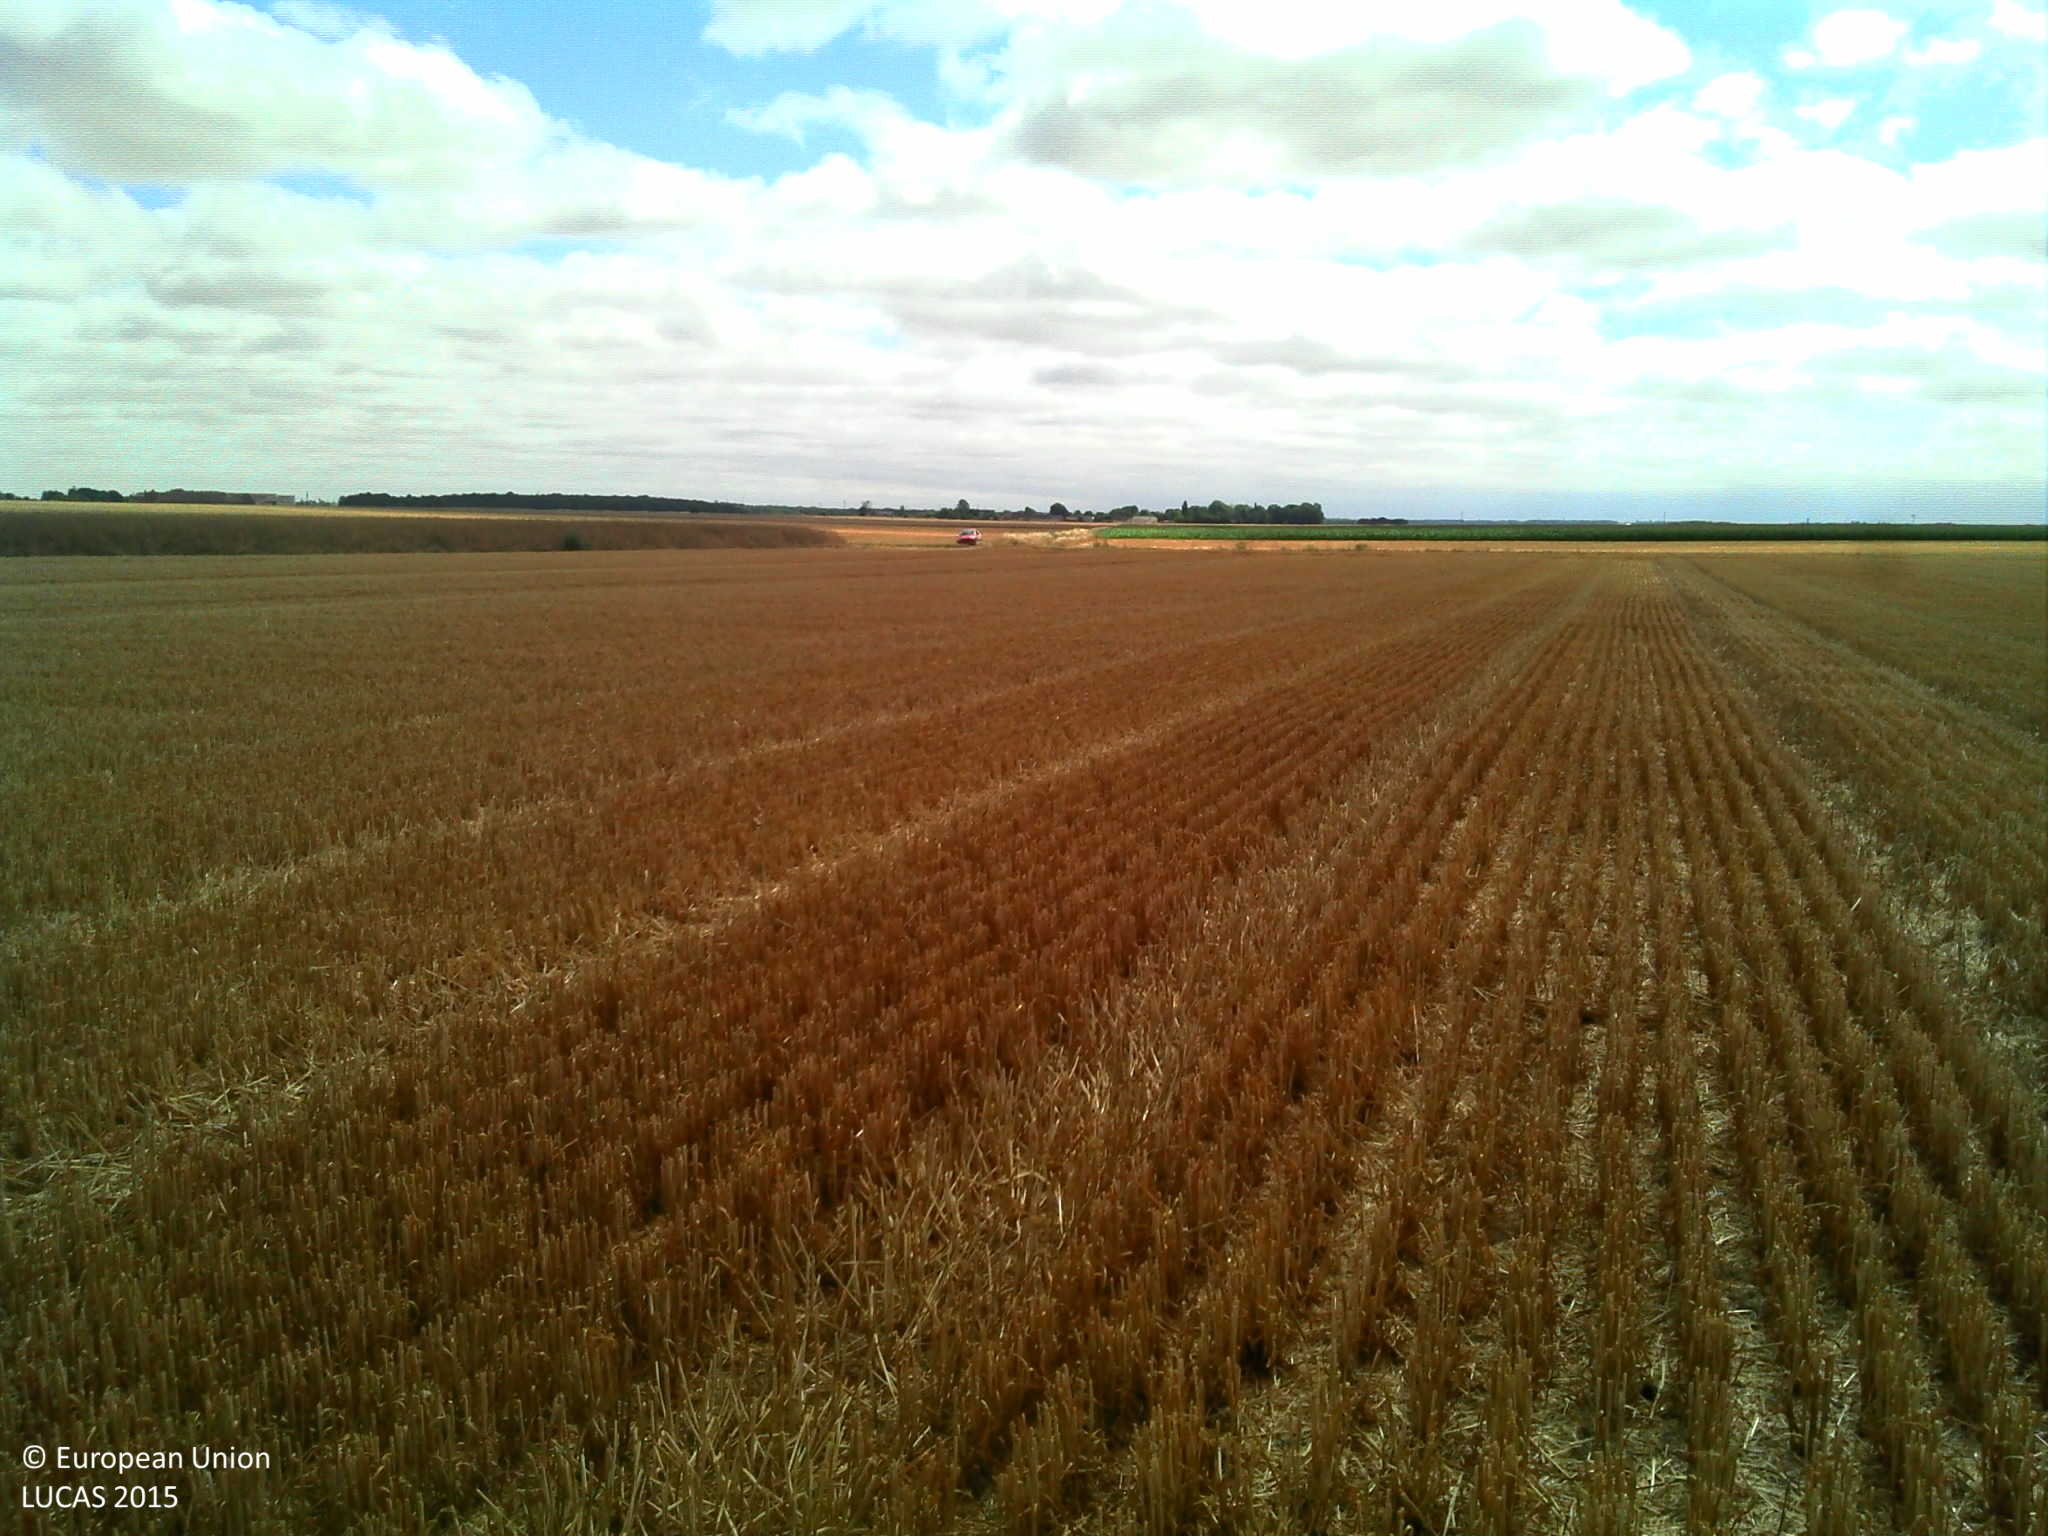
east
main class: Cropland
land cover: Common wheat
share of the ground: > 75 %
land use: Agriculture (excluding fallow land and kitchen gardens)
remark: Harvested field
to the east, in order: Common wheat; Grass margins; Paved roads, cycling and walking lanes; Grass margins; Rape and turnip rape
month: July
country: FR
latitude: 48.2944
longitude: 1.2880
